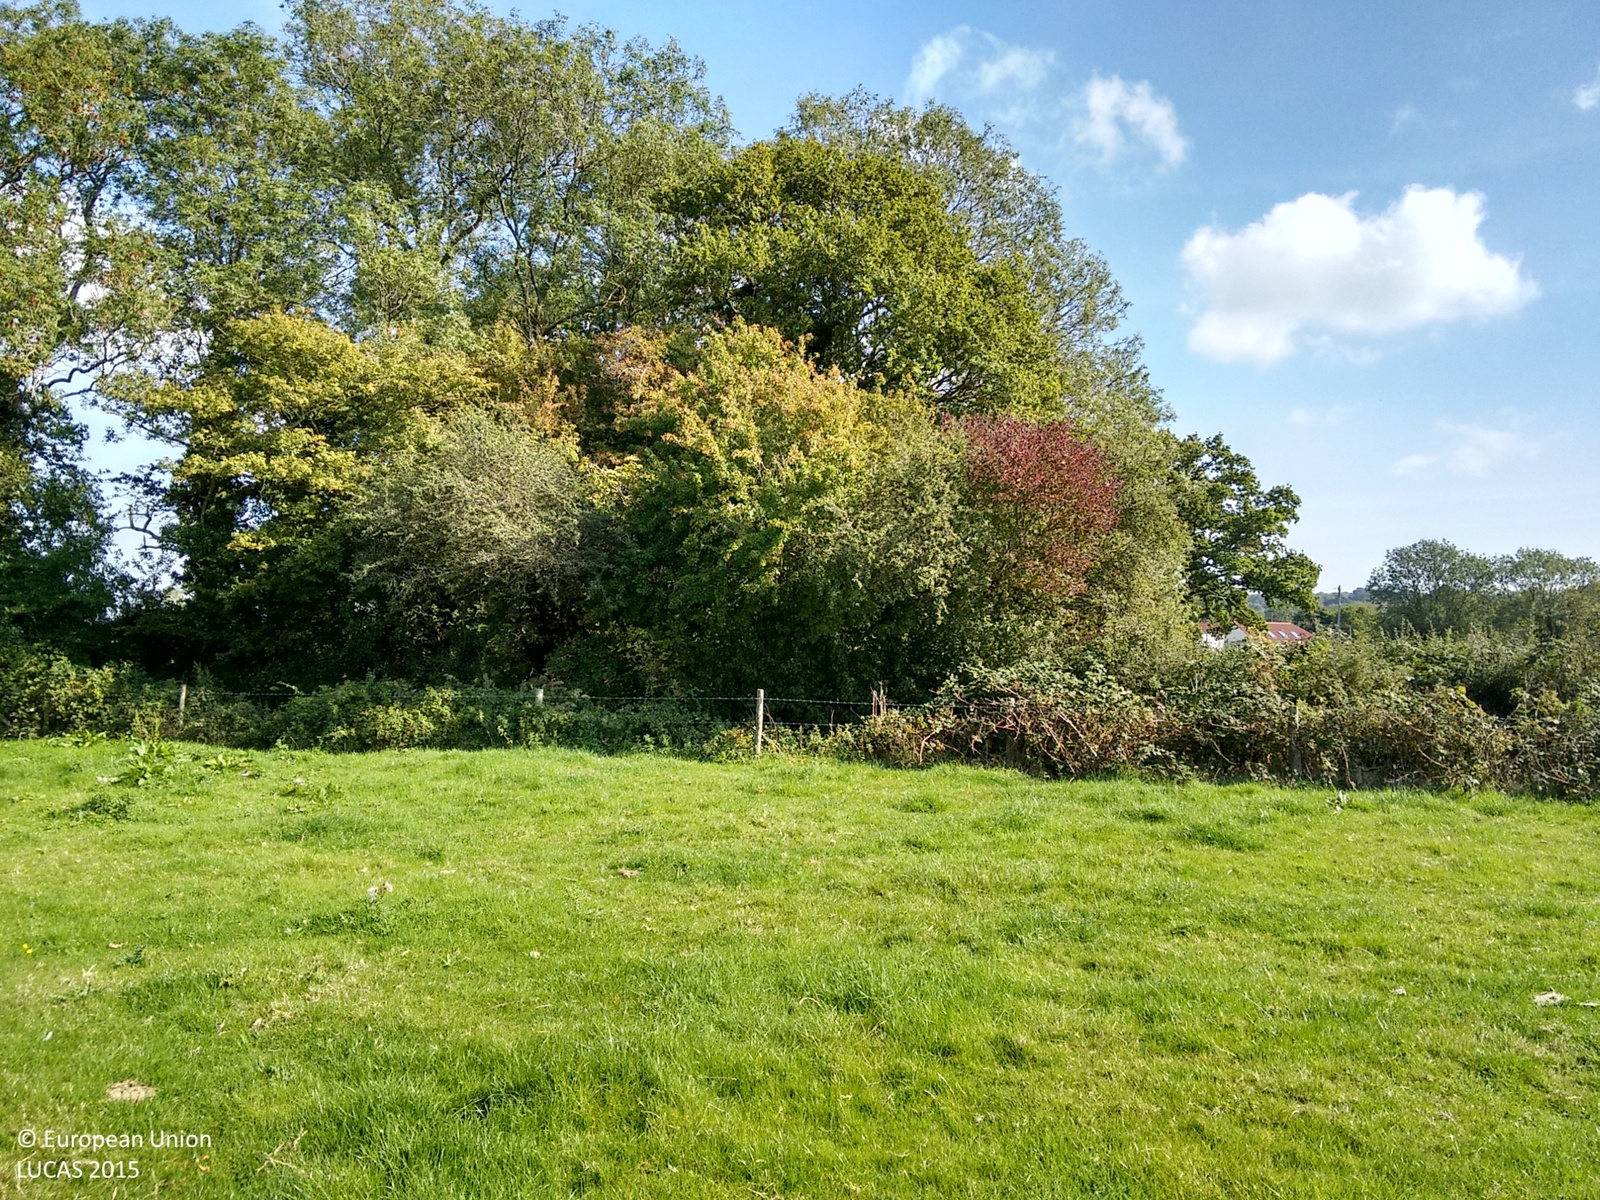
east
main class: Grassland
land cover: Grassland without tree/shrub cover
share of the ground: > 75 %
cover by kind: herbaceous plants 100 %
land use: Agriculture (excluding fallow land and kitchen gardens)
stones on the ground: < 10 %
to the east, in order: Grassland without tree/shrub cover; Fences; Shruby margins; Ditches and canals; Broadleaved woodland; Grass margins; Tracks; Grass margins; Ditches and canals; Grass margins; Fences; Grassland without tree/shrub cover; Fences; Managed hedges; Paved roads, cycling and walking lanes; Grass margins; Rivers and streams; Fences; Grassland without tree/shrub cover; Fences; Rivers and streams; Tracks; Grassland without tree/shrub cover
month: September
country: GB
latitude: 51.6399
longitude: -2.5080
